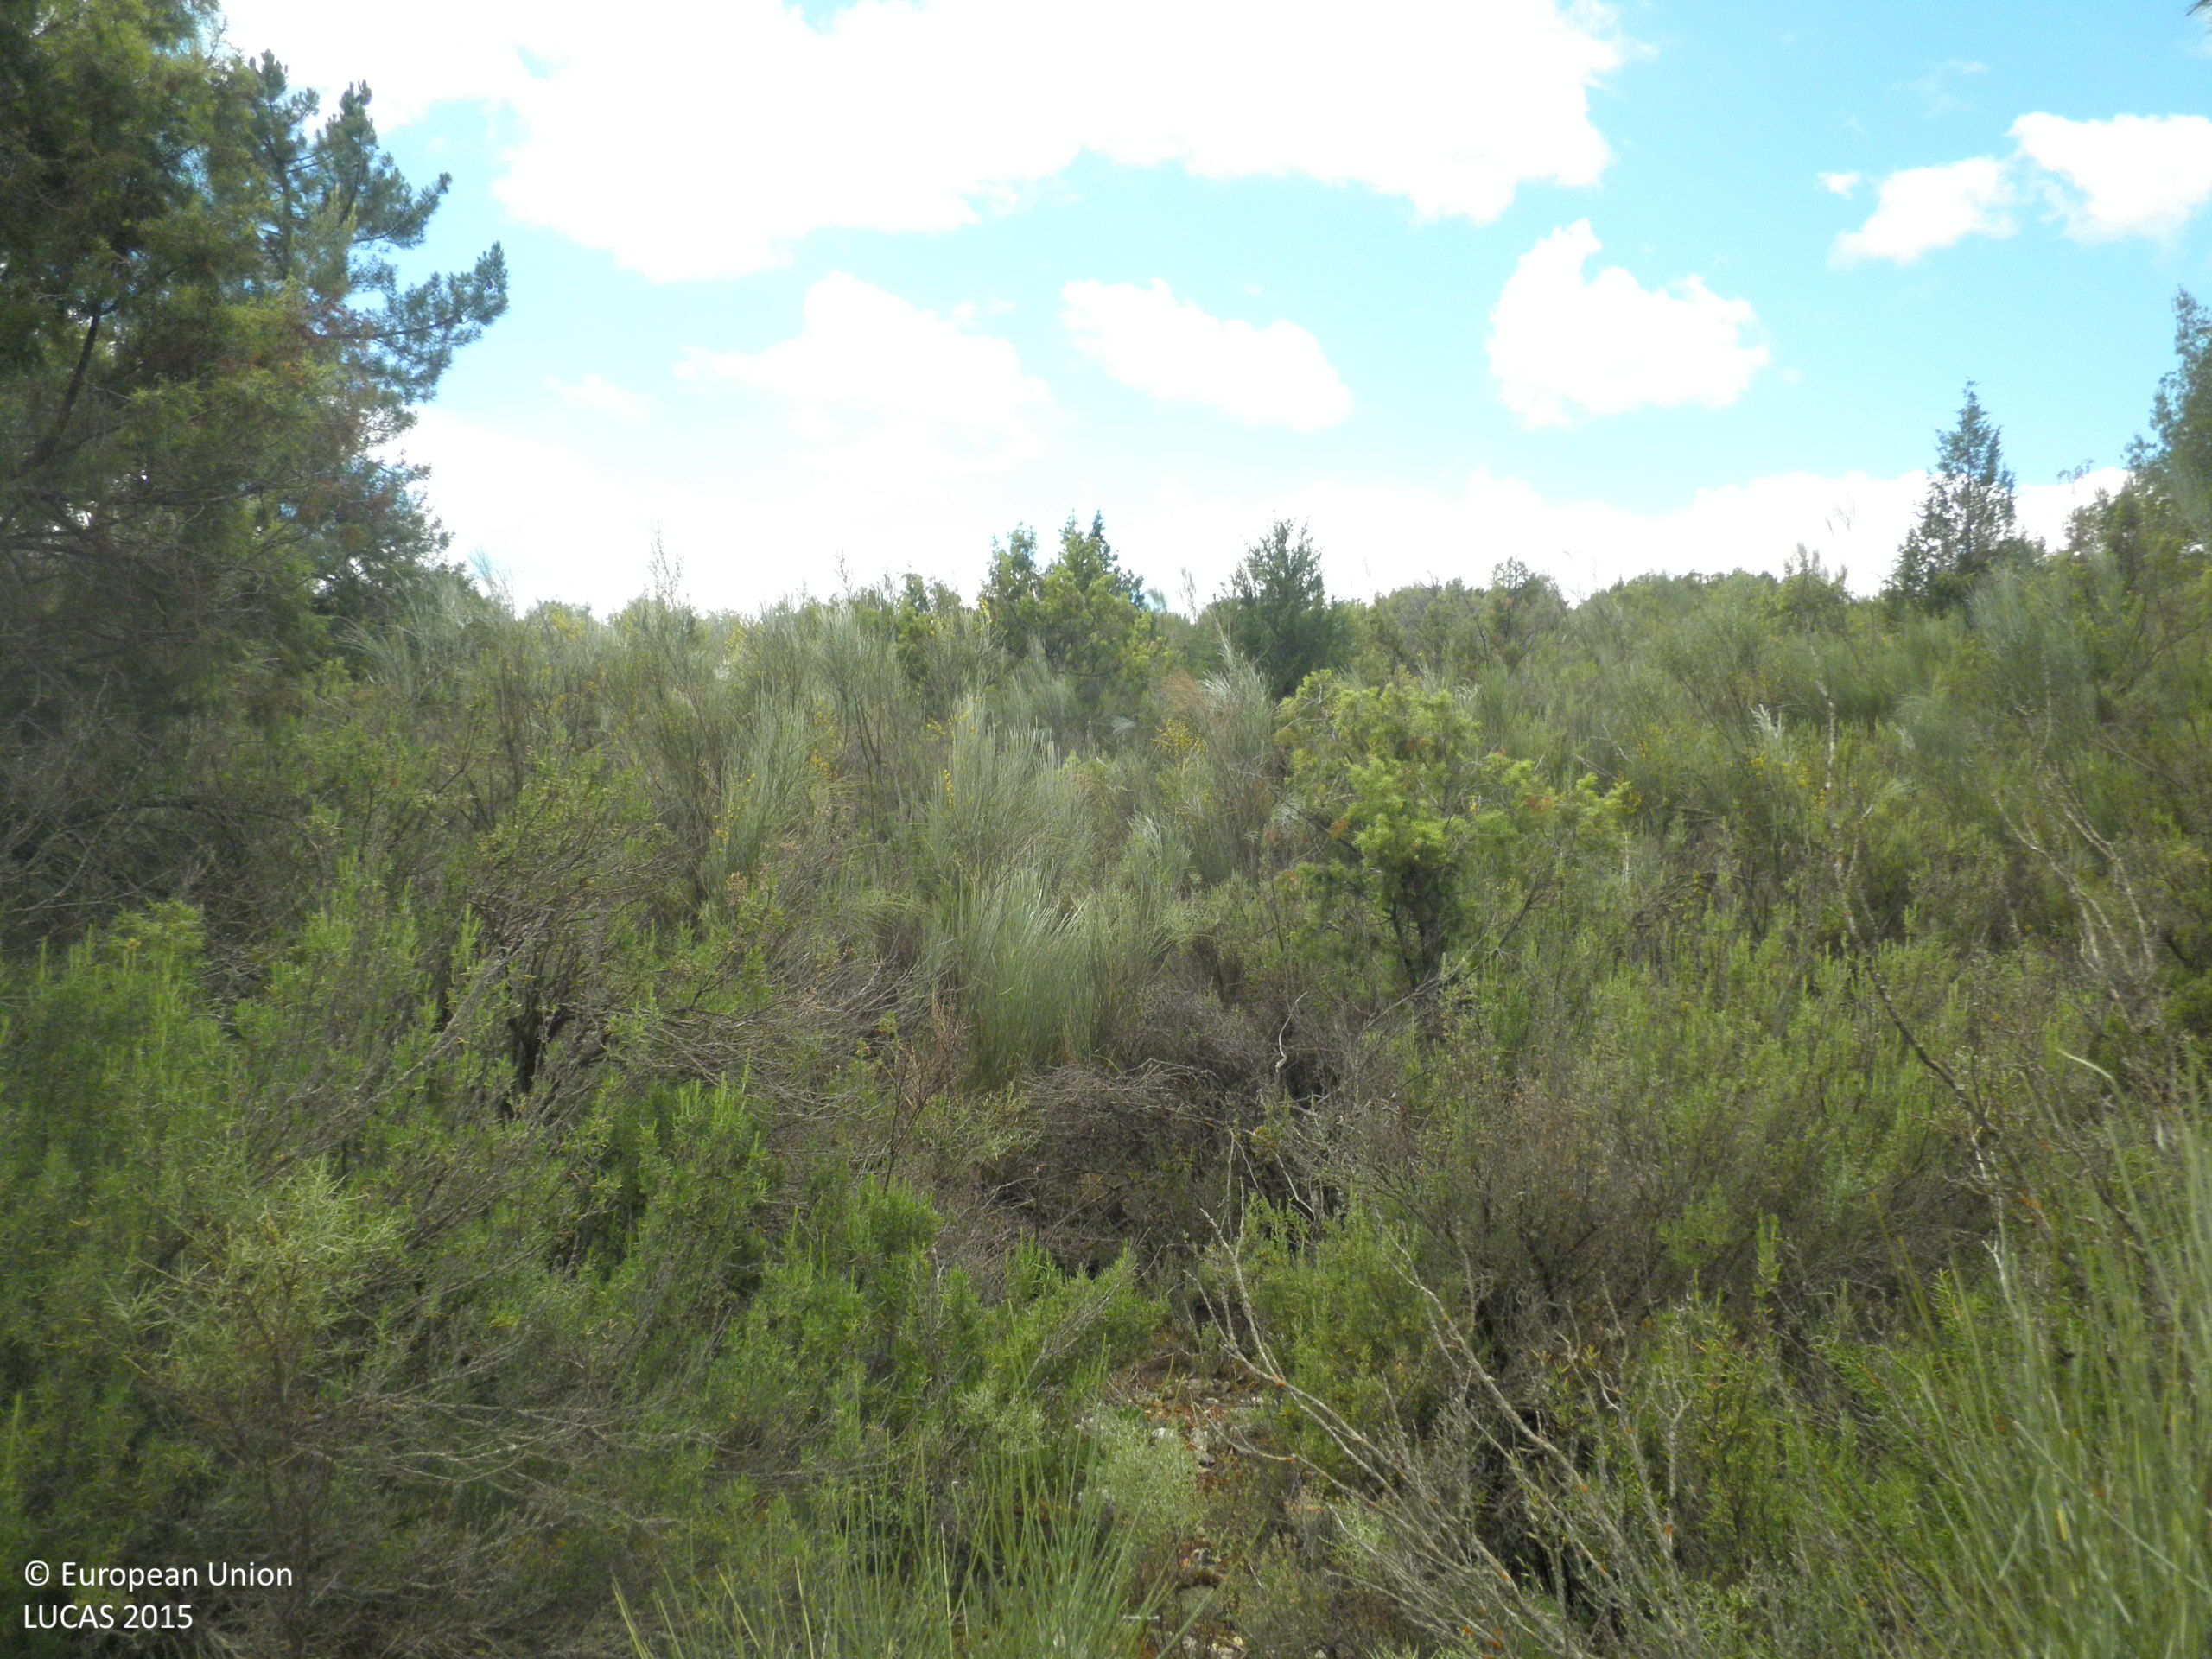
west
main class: Woodland
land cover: Pine dominated coniferous woodland
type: coniferous forest of the mediterranean region
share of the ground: 10 - 25 %
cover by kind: shrubs 75 %, coniferous forest trees 15 %, unconsolidated bare surface 10 %
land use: Semi-natural and natural areas not in use
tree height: > 5 m
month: June
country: ES
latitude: 39.7390
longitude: -1.6183
